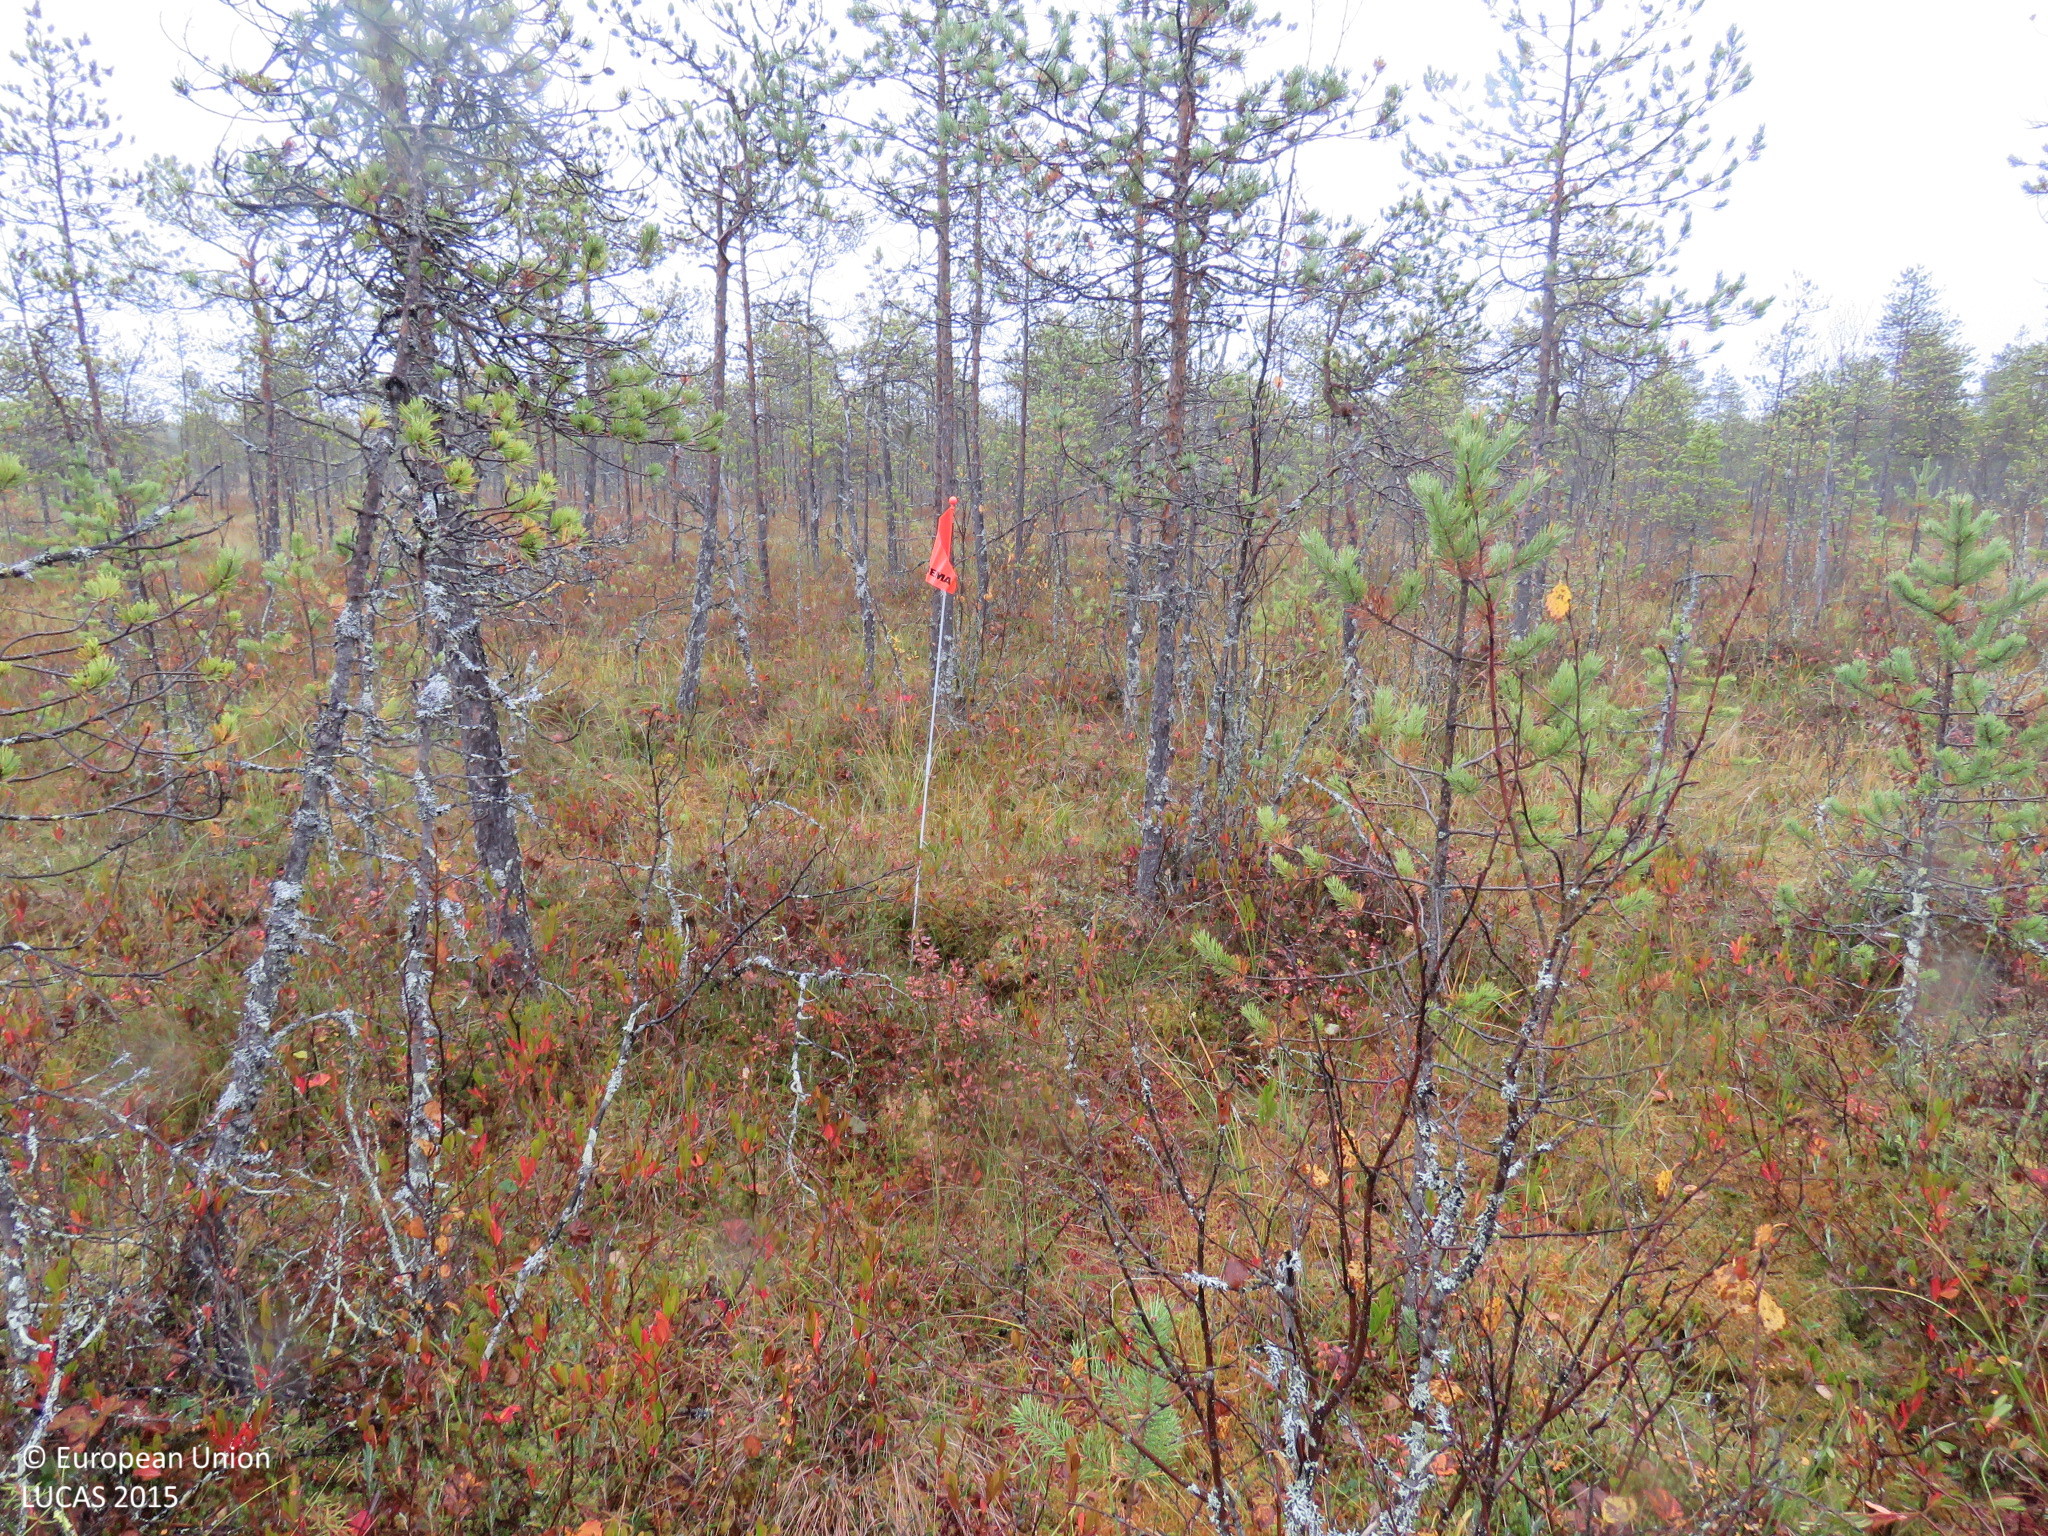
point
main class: Woodland
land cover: Pine dominated coniferous woodland
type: mire and swamp forests
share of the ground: 50 - 75 %
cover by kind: coniferous forest trees 70 %, shrubs 15 %, herbaceous plants 10 %, lichens and mosses 5 %
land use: Semi-natural and natural areas not in use
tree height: < 5 m
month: September
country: FI
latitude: 64.8653
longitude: 26.6351
